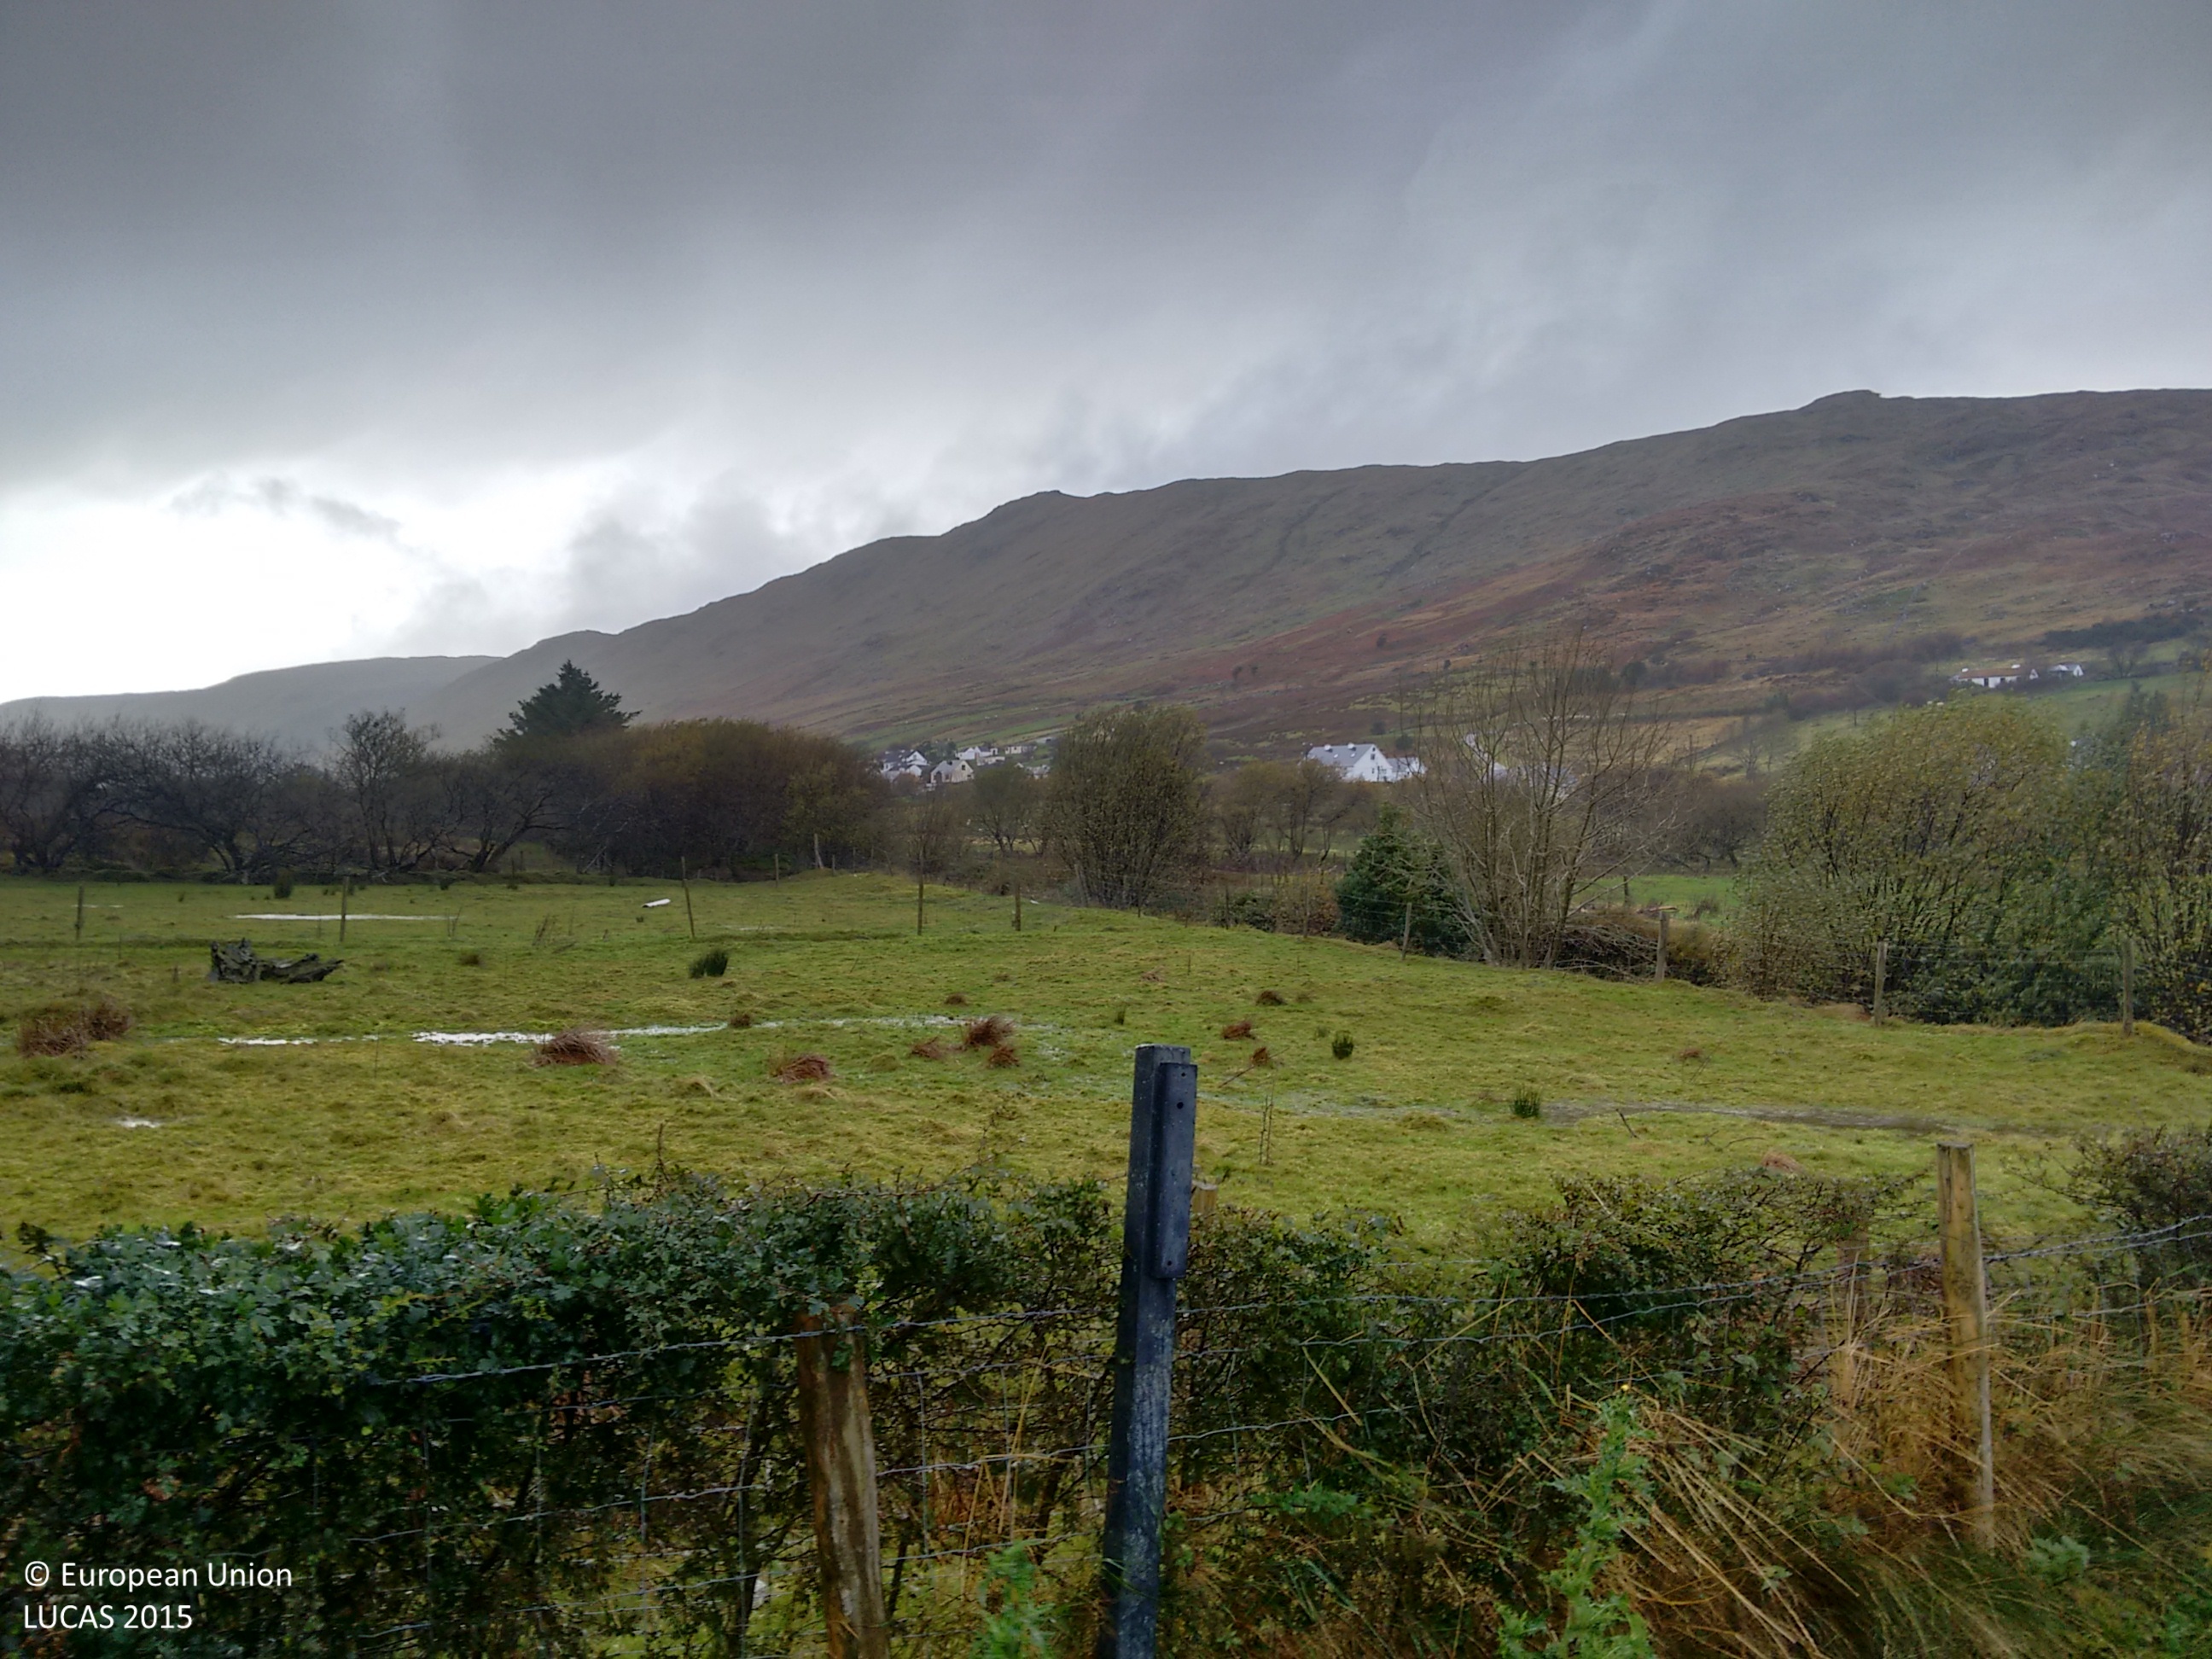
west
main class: Grassland
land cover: Grassland without tree/shrub cover
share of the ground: > 75 %
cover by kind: herbaceous plants 80 %, lichens and mosses 20 %
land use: Agriculture (excluding fallow land and kitchen gardens)
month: November
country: IE
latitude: 54.7403
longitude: -8.4391
